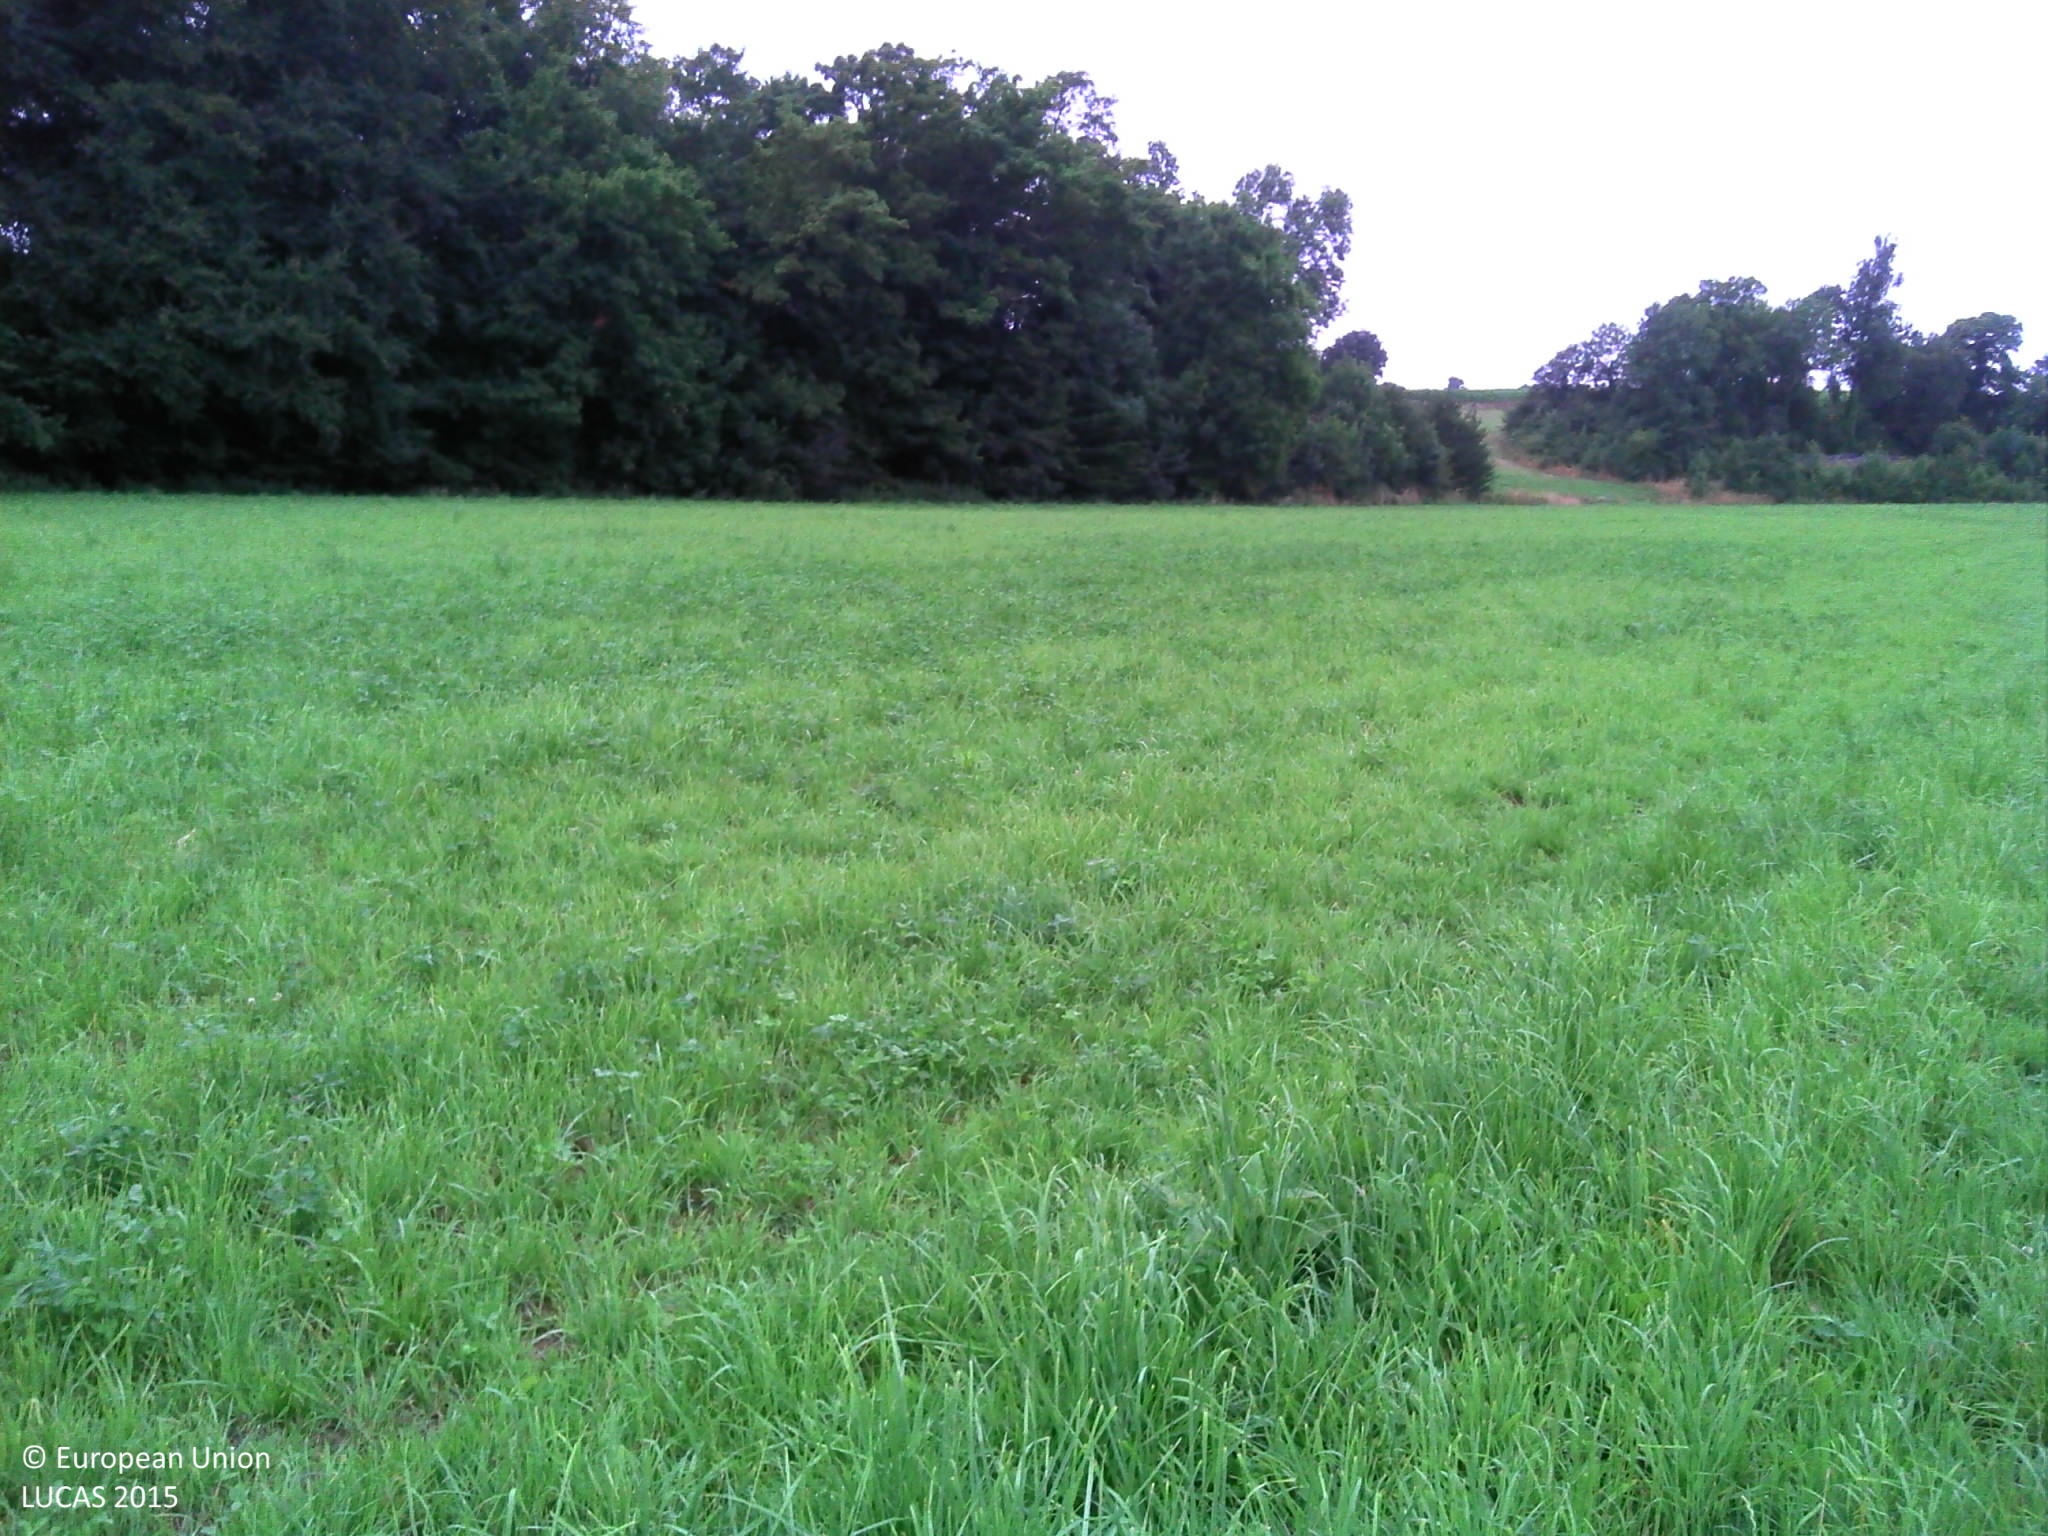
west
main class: Grassland
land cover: Grassland without tree/shrub cover
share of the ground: > 75 %
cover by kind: herbaceous plants 100 %
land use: Agriculture (excluding fallow land and kitchen gardens)
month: July
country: FR
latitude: 48.8669
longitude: -0.2713
